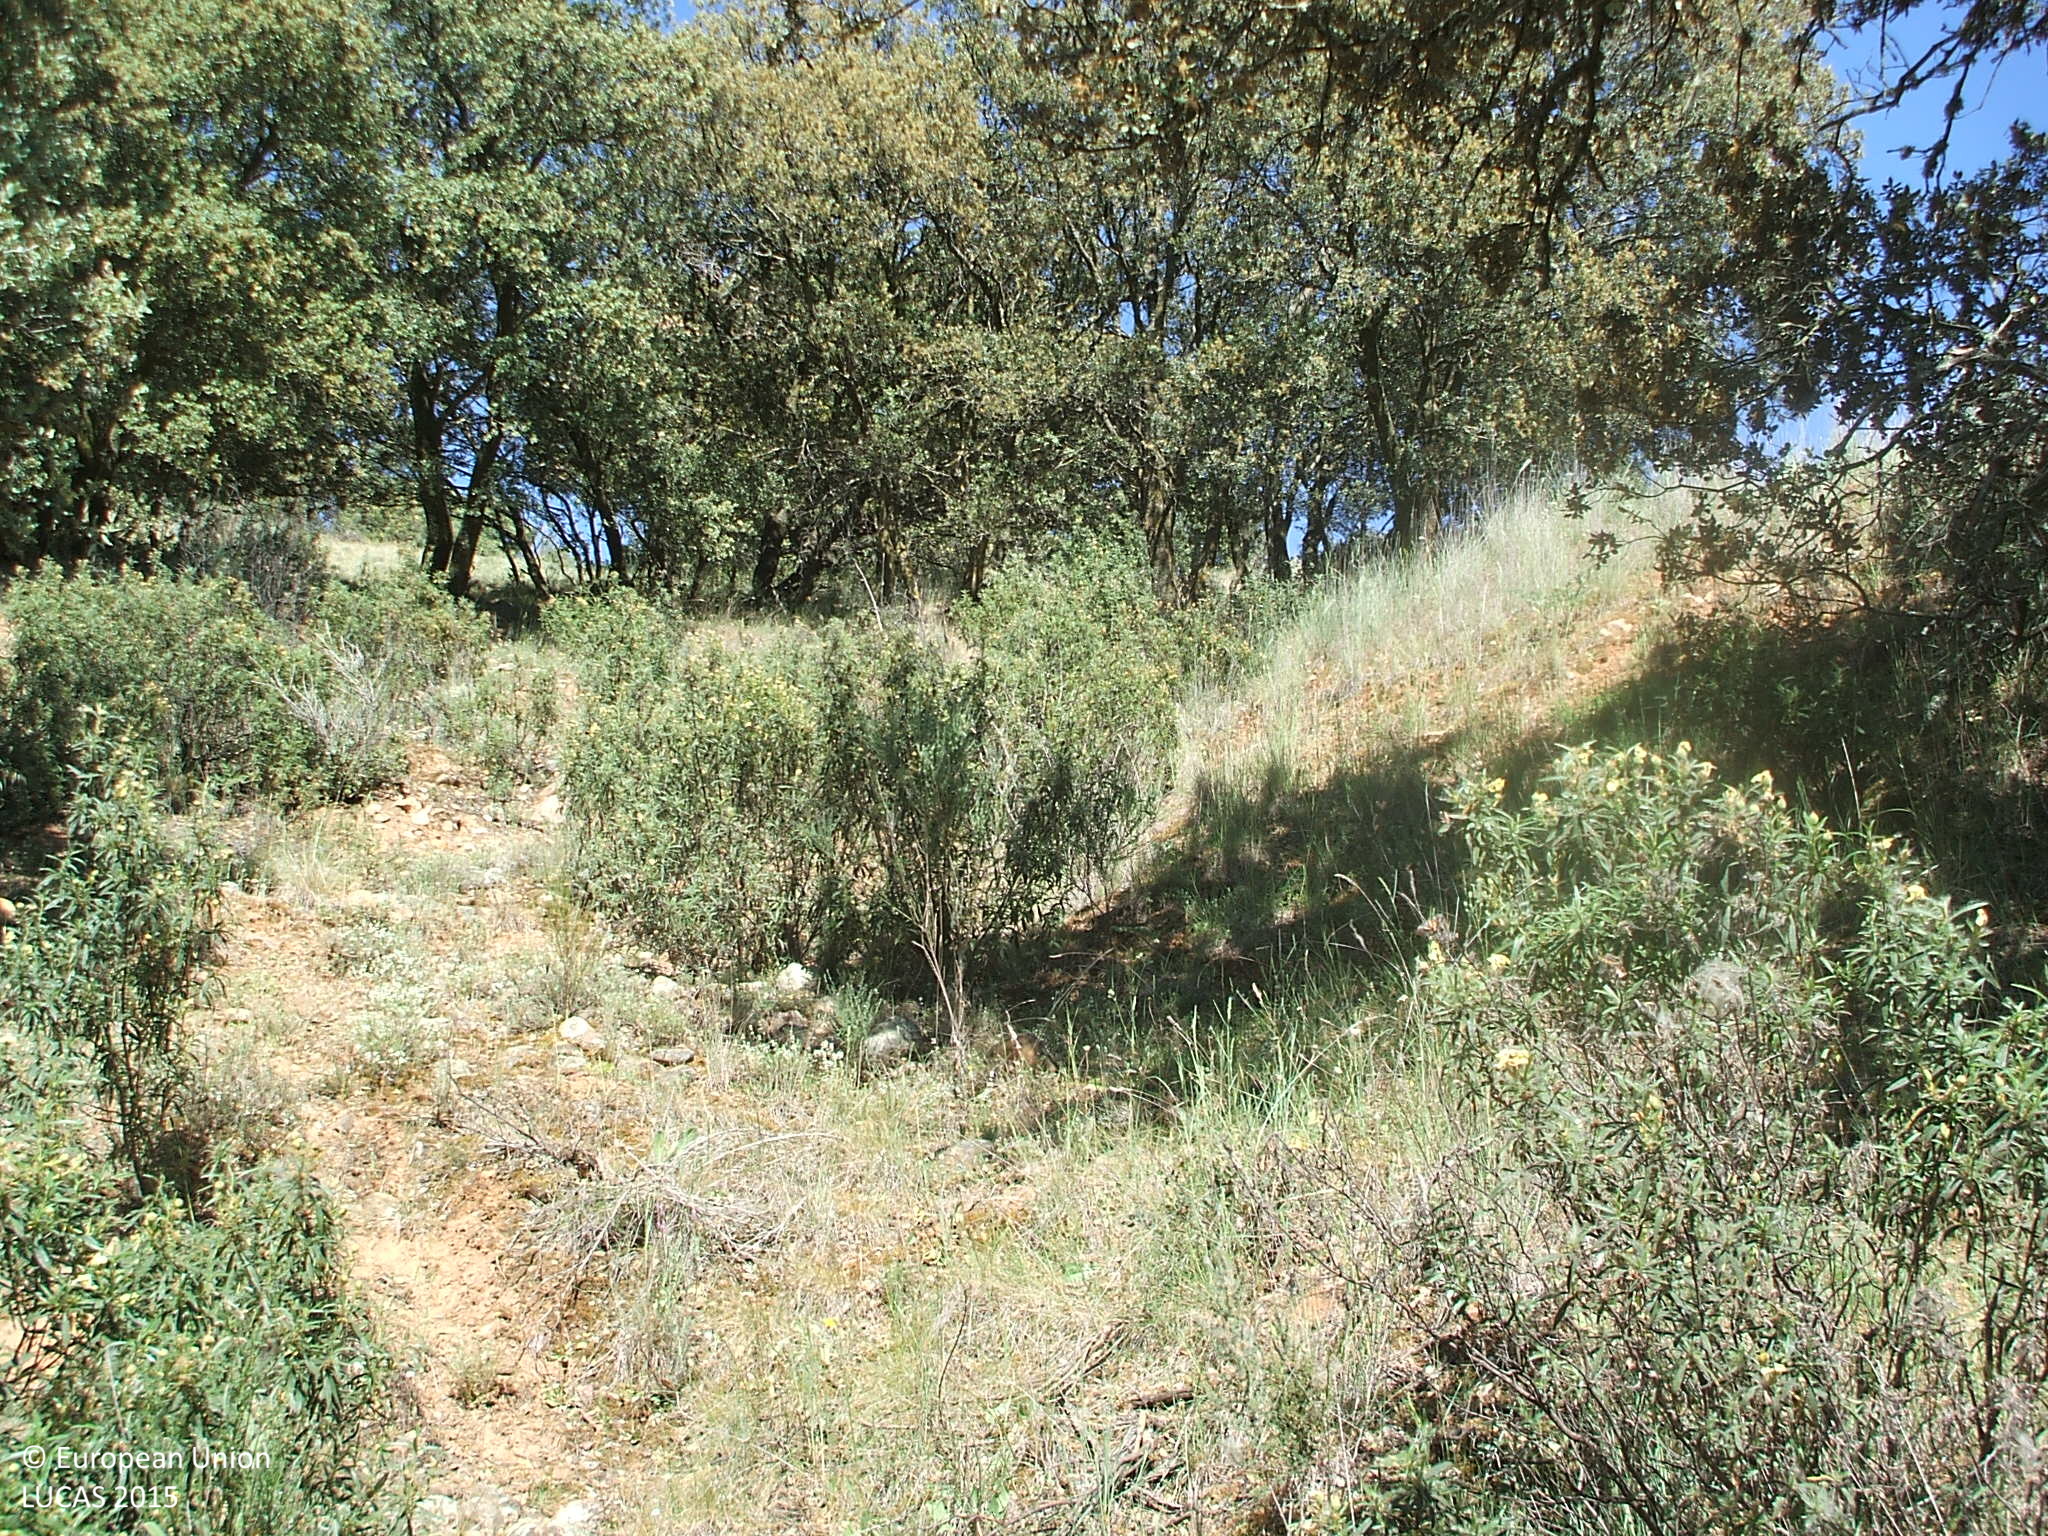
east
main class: Woodland
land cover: Broadleaved woodland
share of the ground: 10 - 25 %
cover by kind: shrubs 30 %, unconsolidated bare surface 30 %, broadleaved forest trees 20 %, herbaceous plants 20 %
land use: Semi-natural and natural areas not in use
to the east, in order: Broadleaved woodland; Grassland with sparse tree/shrub cover; Fences; Paved roads, cycling and walking lanes
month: May
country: ES
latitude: 40.9151
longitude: -3.0124
